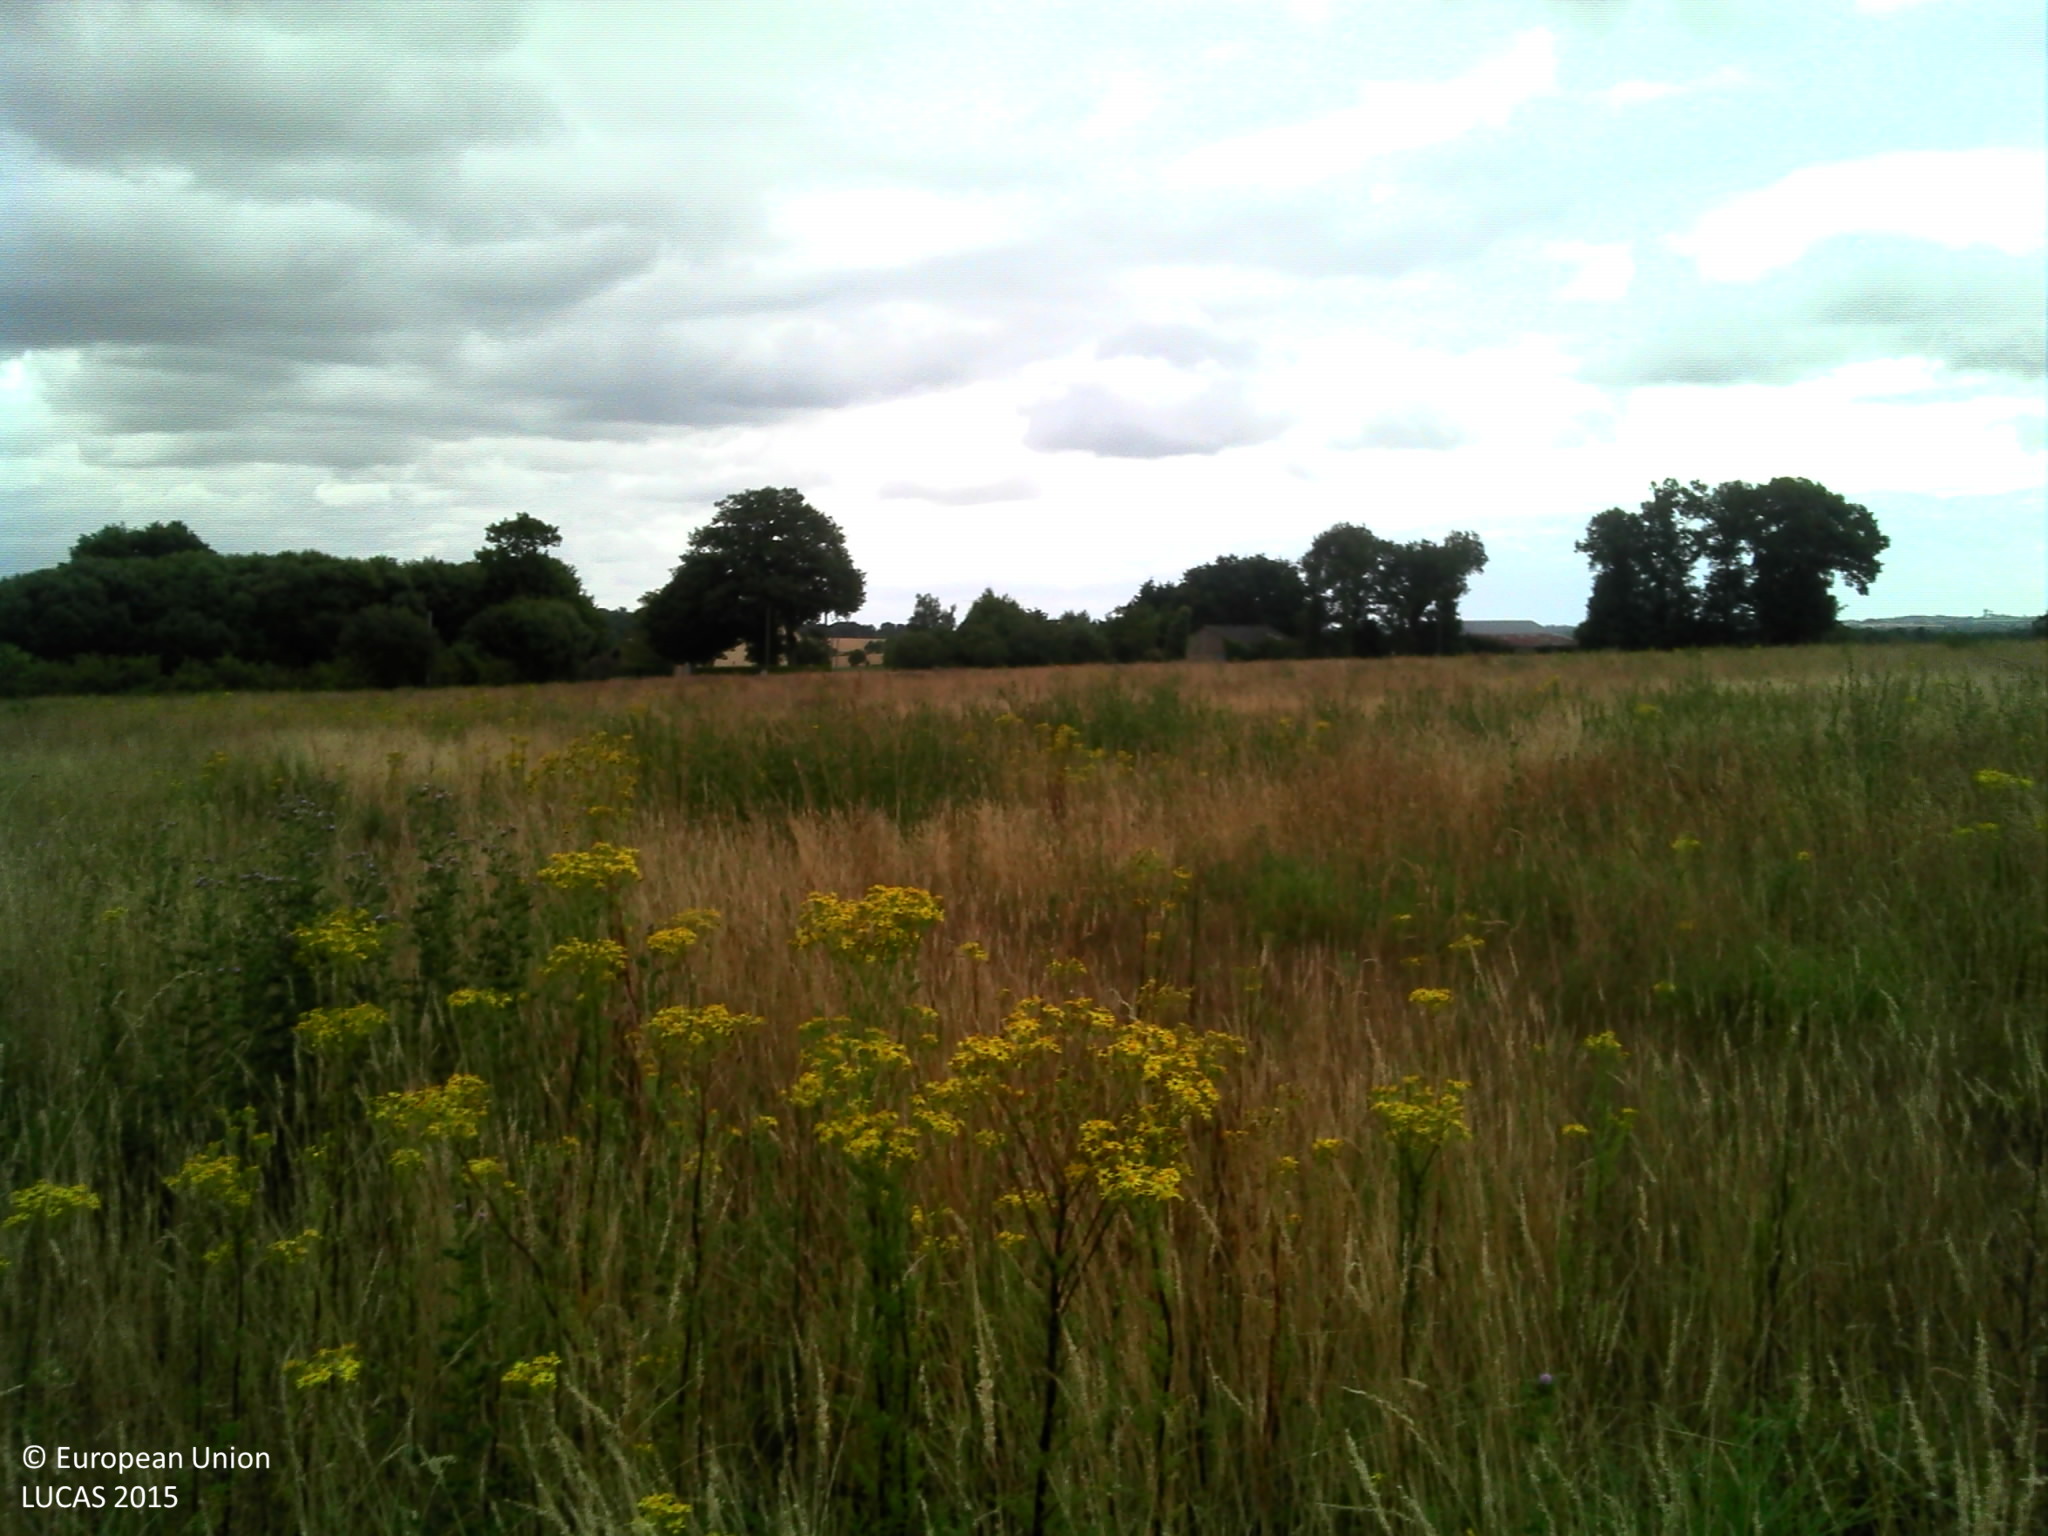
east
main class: Grassland
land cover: Grassland without tree/shrub cover
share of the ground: > 75 %
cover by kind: herbaceous plants 100 %
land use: Agriculture (excluding fallow land and kitchen gardens)
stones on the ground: 10 - 25 %
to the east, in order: Grassland without tree/shrub cover; Ditches and canals; Grass margins; Paved roads, cycling and walking lanes; Electric lines; Grass margins; Ditches and canals; Lines of trees; Grassland without tree/shrub cover; Broadleaved woodland; Grassland without tree/shrub cover; Fences; Grassland without tree/shrub cover; Electric lines; Grassland without tree/shrub cover; Artificial constructions in urban areas
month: July
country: FR
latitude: 47.8726
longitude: -2.0177
